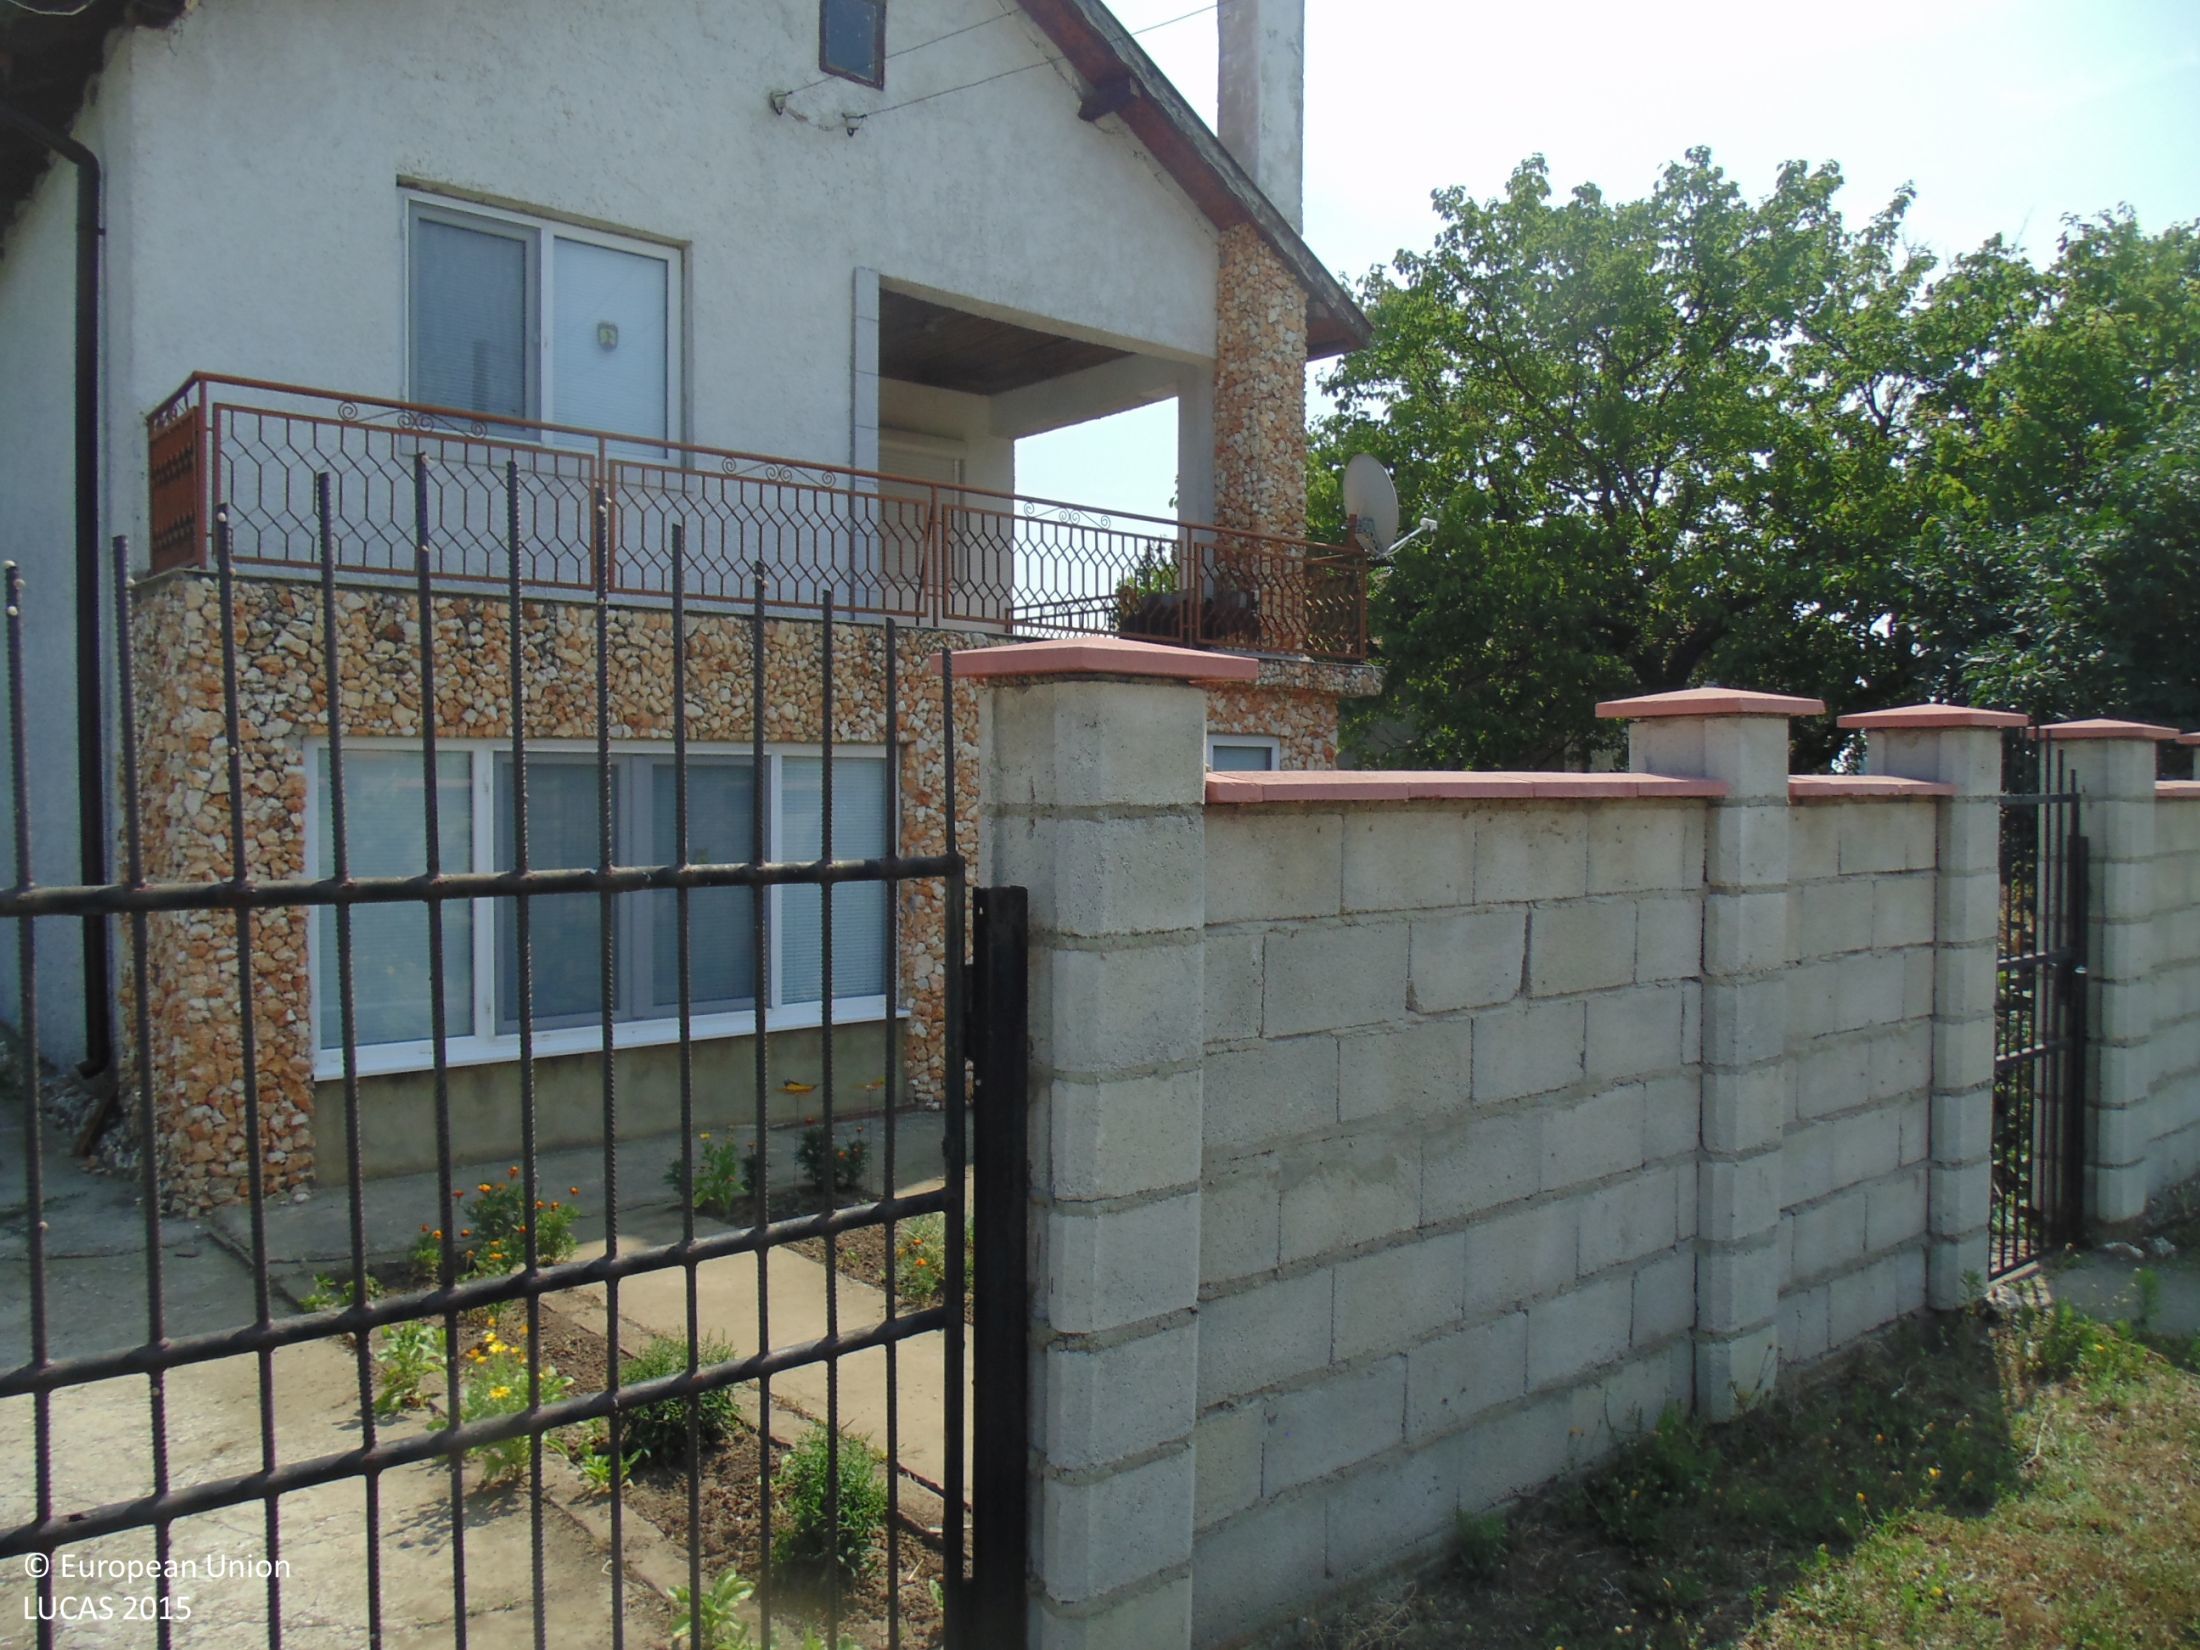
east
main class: Cropland
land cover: Other fruit trees and berries
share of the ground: 25 - 50 %
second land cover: Grassland without tree/shrub cover
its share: > 75 %
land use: Kitchen garden
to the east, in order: Other fruit trees and berries; Grassland without tree/shrub cover; Artificial constructions in urban areas; Grass margins; Paved roads, cycling and walking lanes; Grassland with sparse tree/shrub cover; Tracks; Grass margins; Grassland with sparse tree/shrub cover; Grassland without tree/shrub cover; Tracks; Grassland without tree/shrub cover
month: July
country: BG
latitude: 43.6132
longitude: 27.9765
